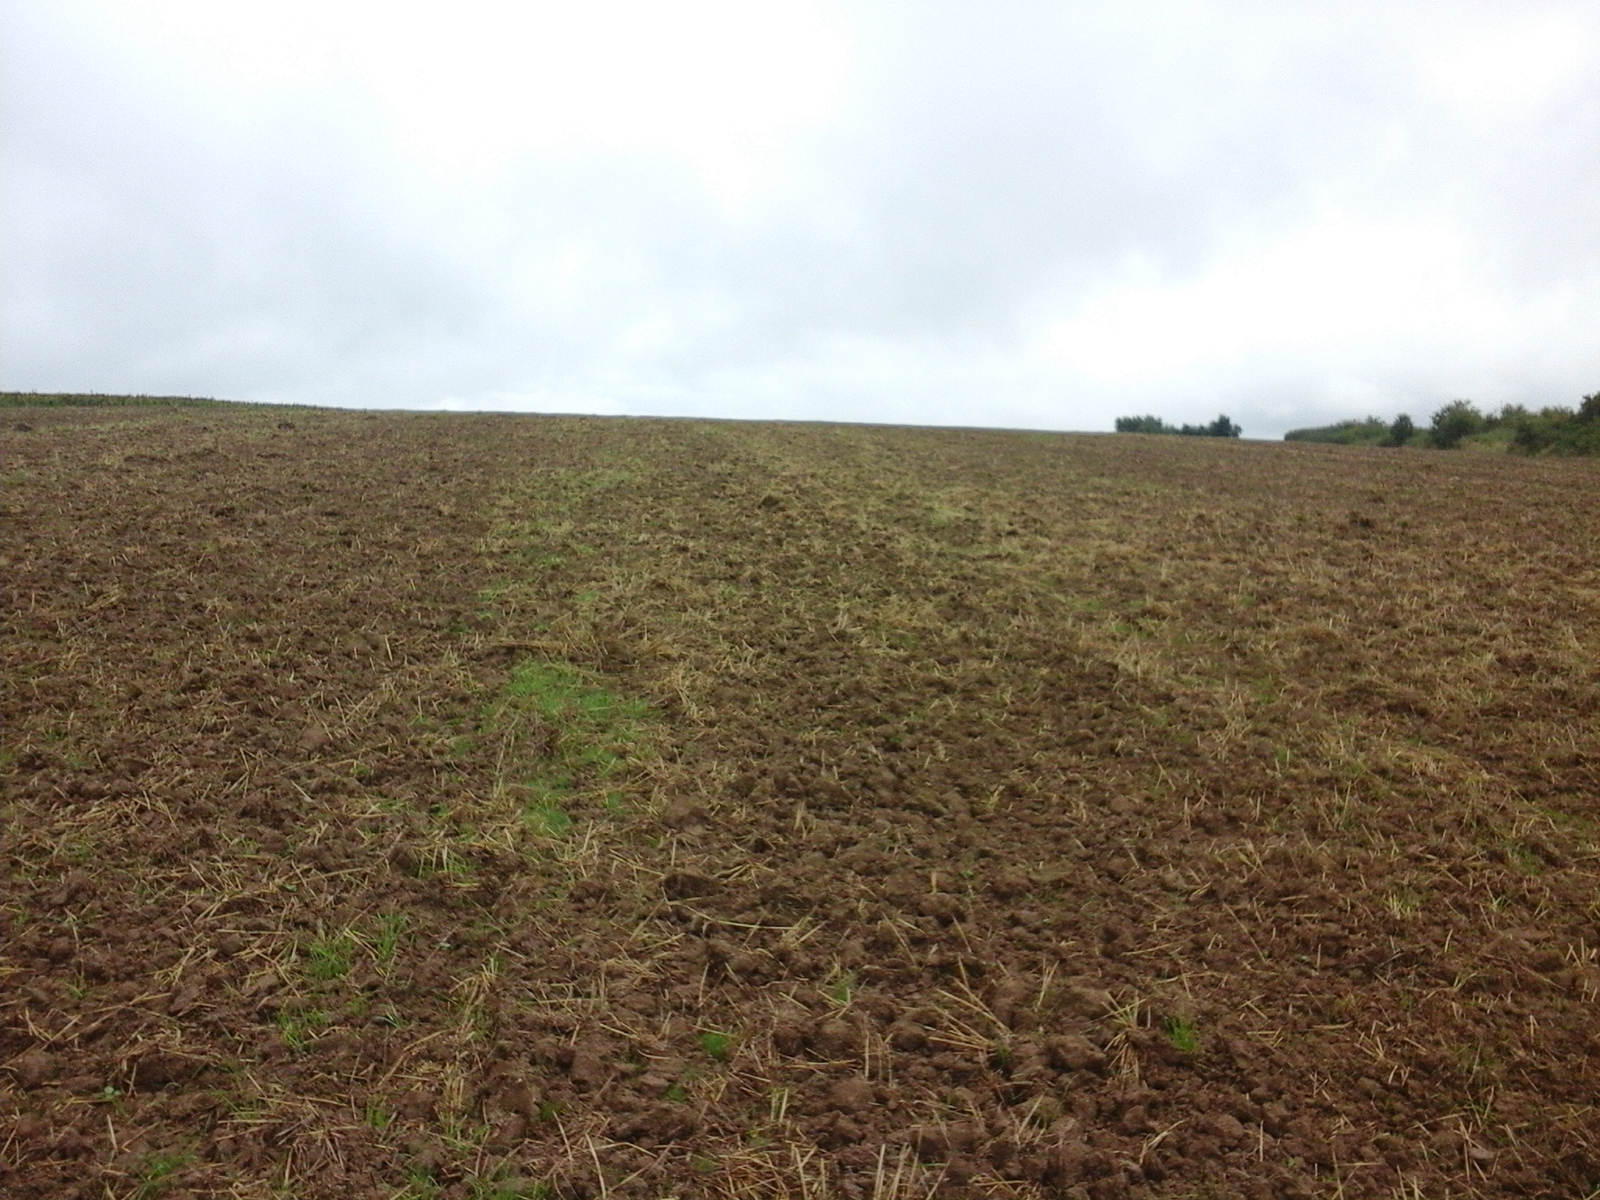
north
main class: Cropland
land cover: Common wheat
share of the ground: < 10 %
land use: Agriculture (excluding fallow land and kitchen gardens)
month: September
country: RO
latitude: 46.8060
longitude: 21.9568
